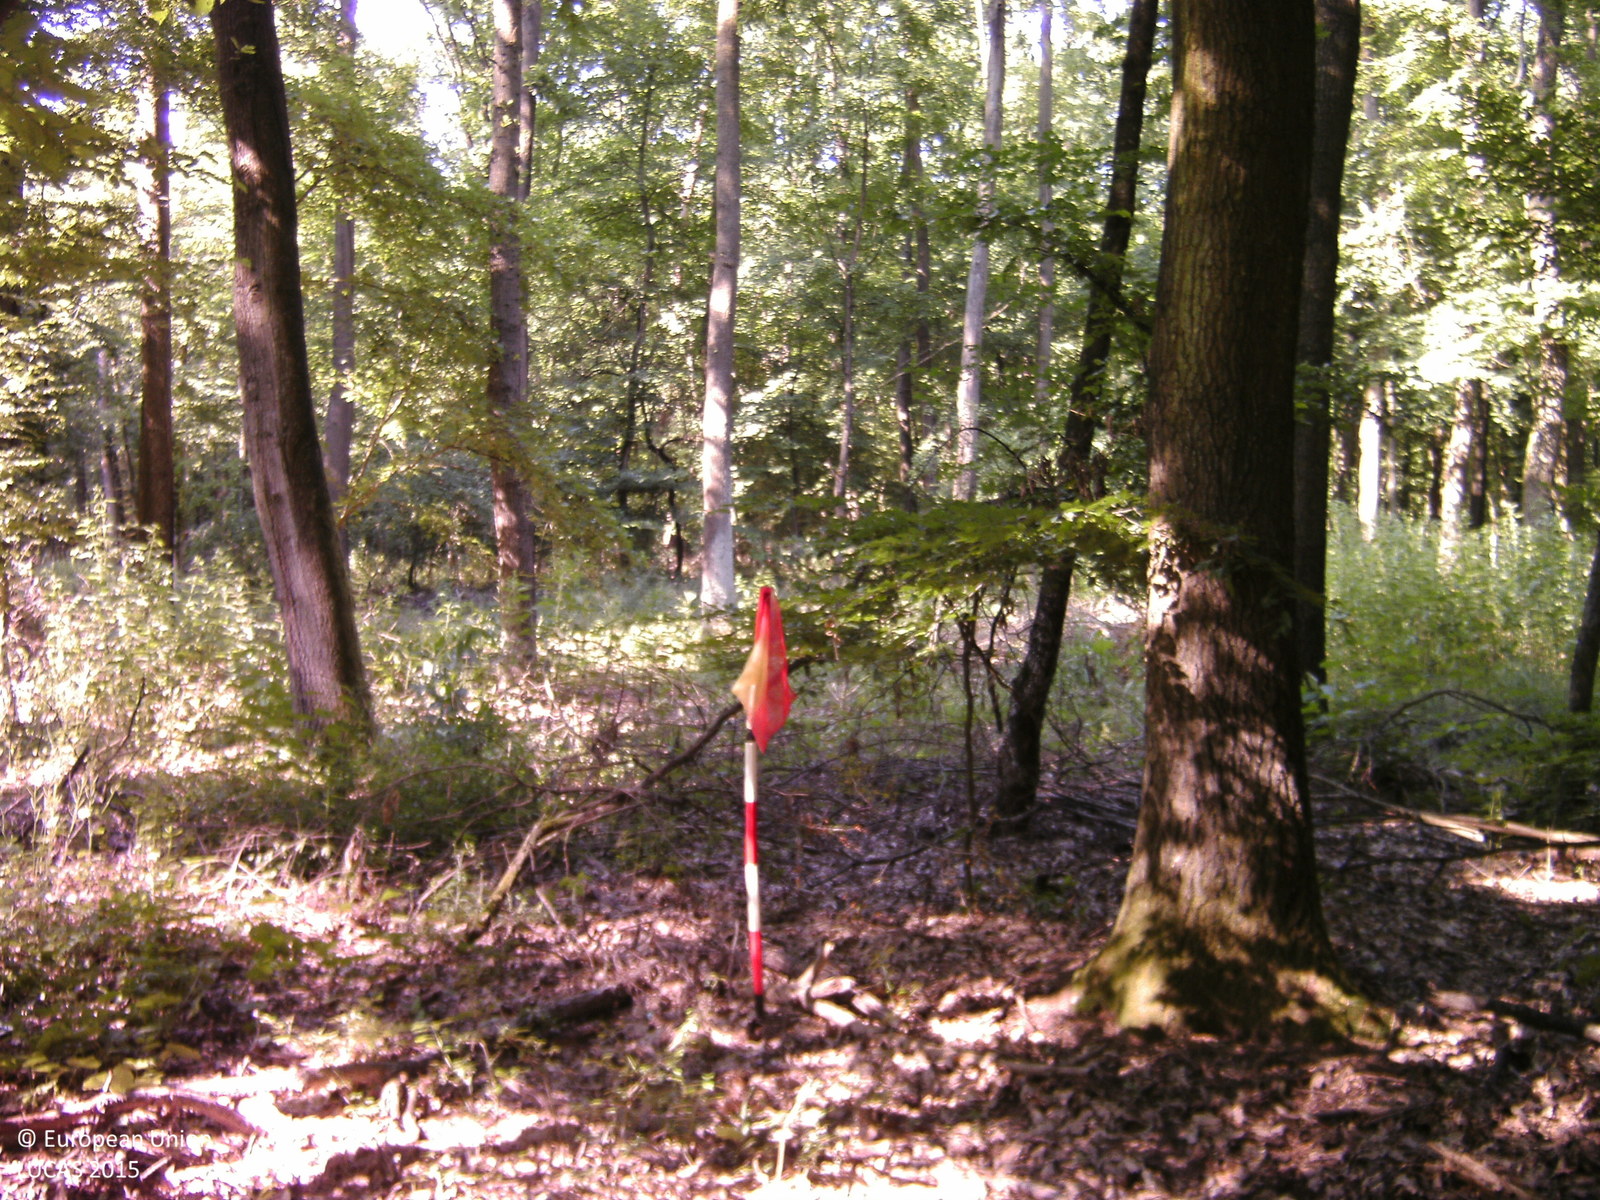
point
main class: Woodland
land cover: Broadleaved woodland
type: mesophytic deciduous forest
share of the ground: > 75 %
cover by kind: broadleaved forest trees 90 %, shrubs 5 %, herbaceous plants 5 %
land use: Forestry
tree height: > 5 m
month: June
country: HU
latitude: 46.4420
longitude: 17.8554
